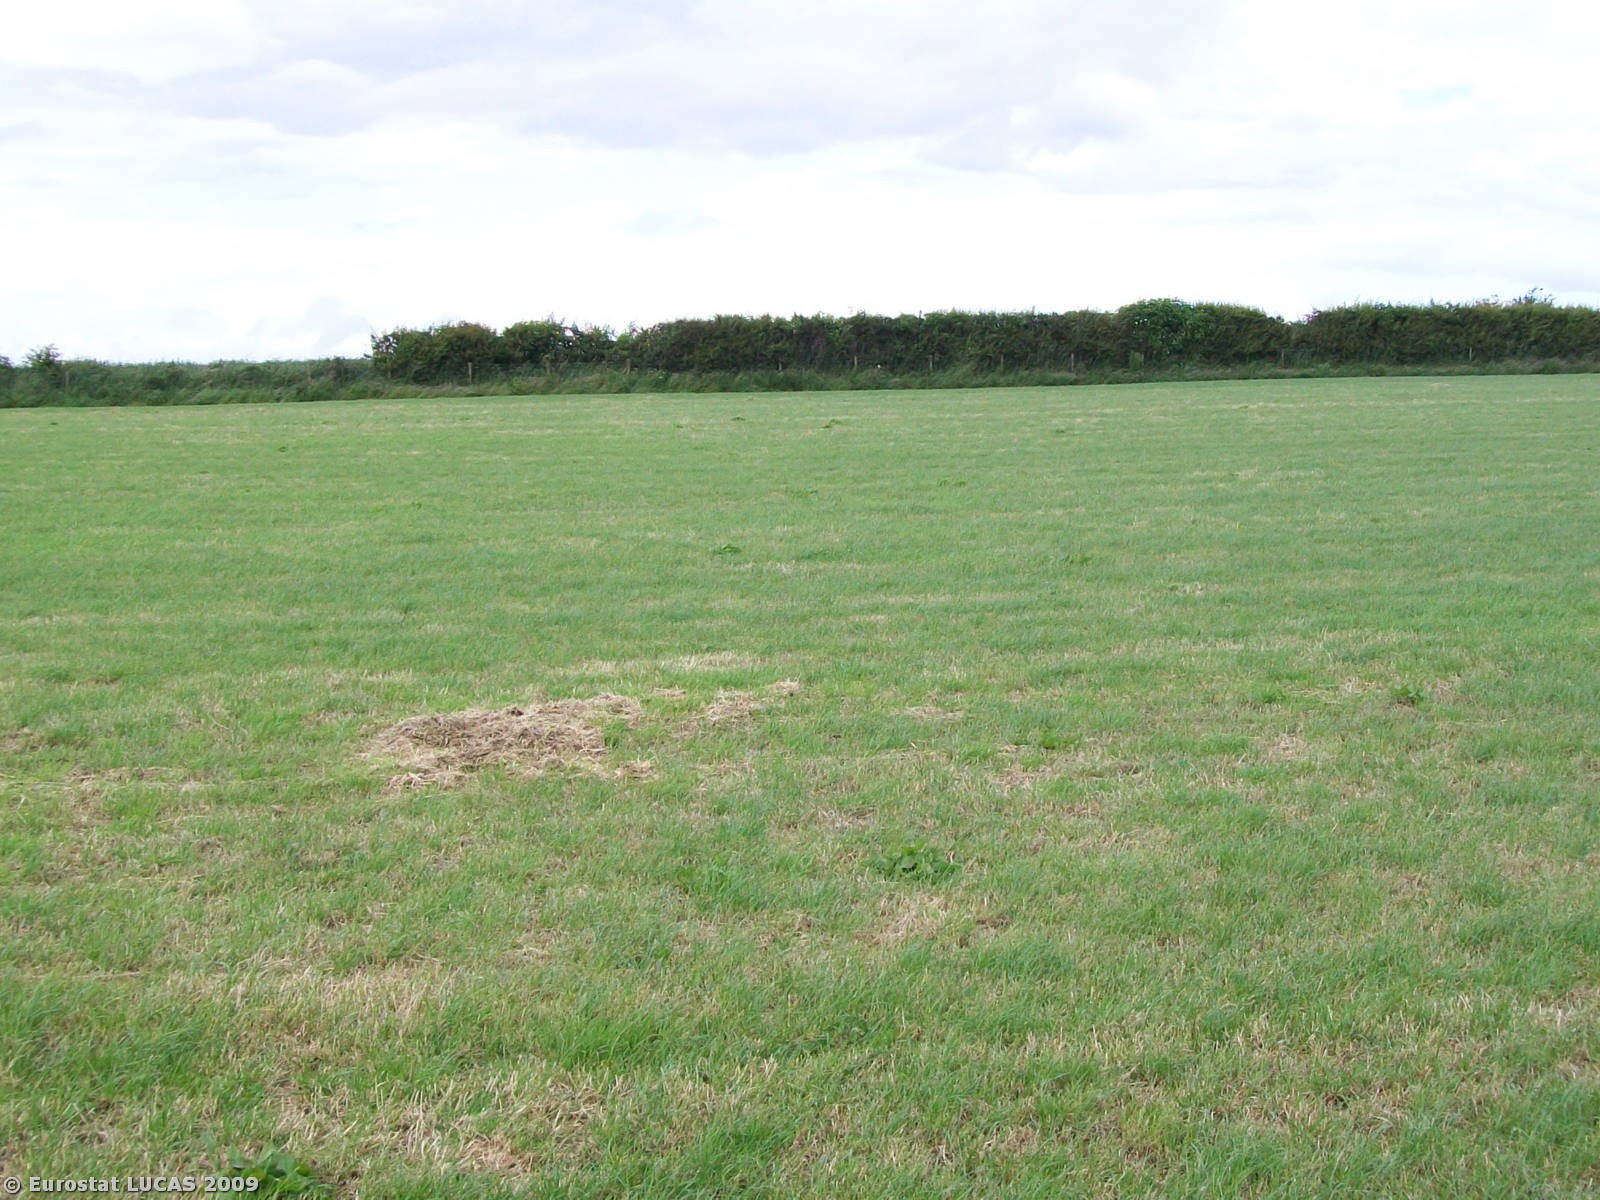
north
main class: Cropland
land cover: Temporary grasslands
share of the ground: > 75 %
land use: Agriculture (excluding fallow land and kitchen gardens)
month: June
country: GB
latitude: 54.8382
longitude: -3.2646
